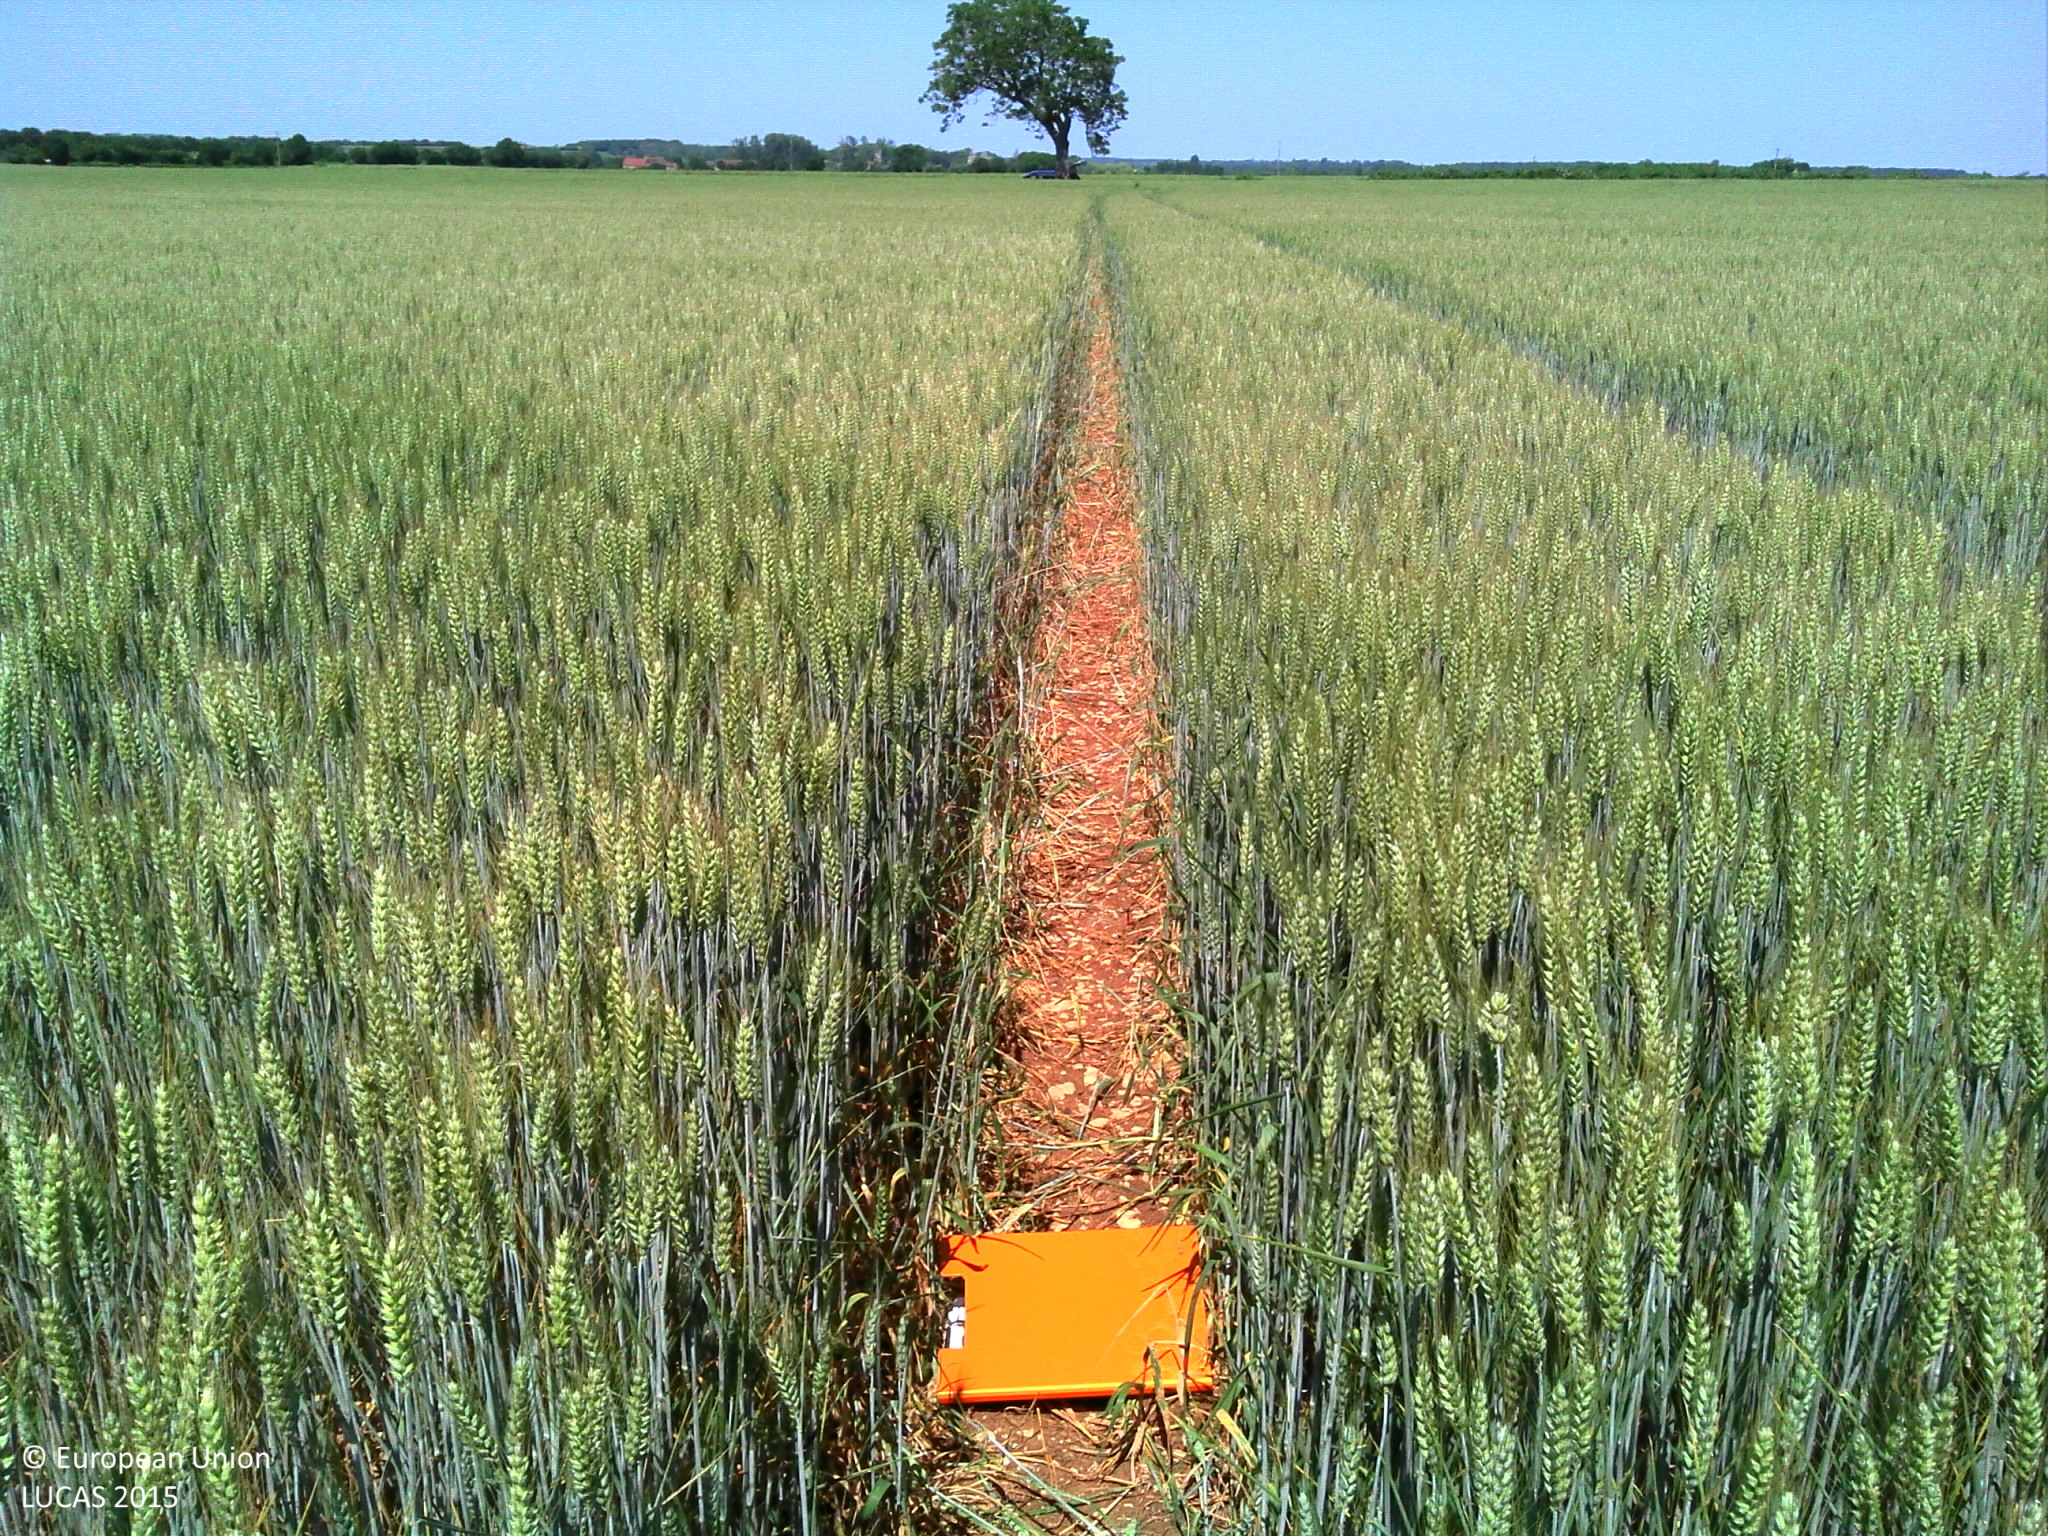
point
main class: Cropland
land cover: Common wheat
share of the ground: > 75 %
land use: Agriculture (excluding fallow land and kitchen gardens)
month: June
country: FR
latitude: 46.8798
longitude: 2.7122
